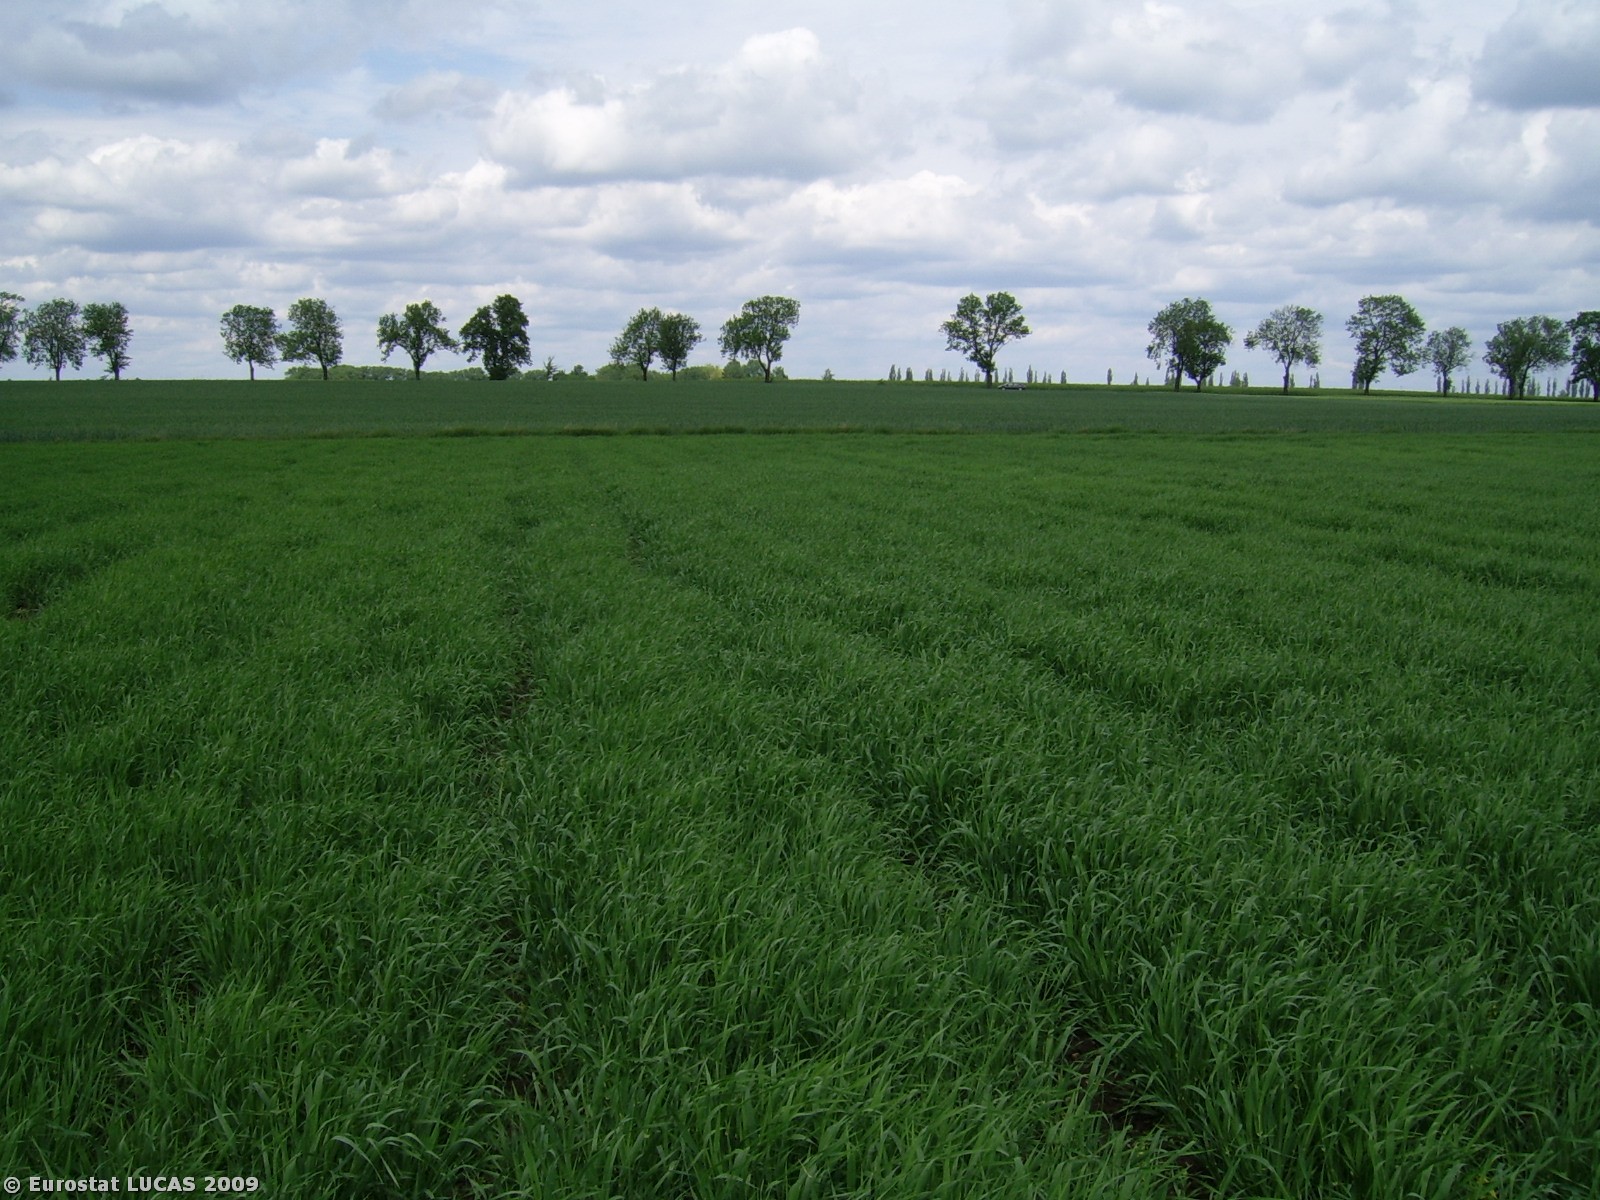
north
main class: Cropland
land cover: Barley
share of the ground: > 75 %
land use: Agriculture (excluding fallow land and kitchen gardens)
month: May
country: PL
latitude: 52.8546
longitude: 18.1695
